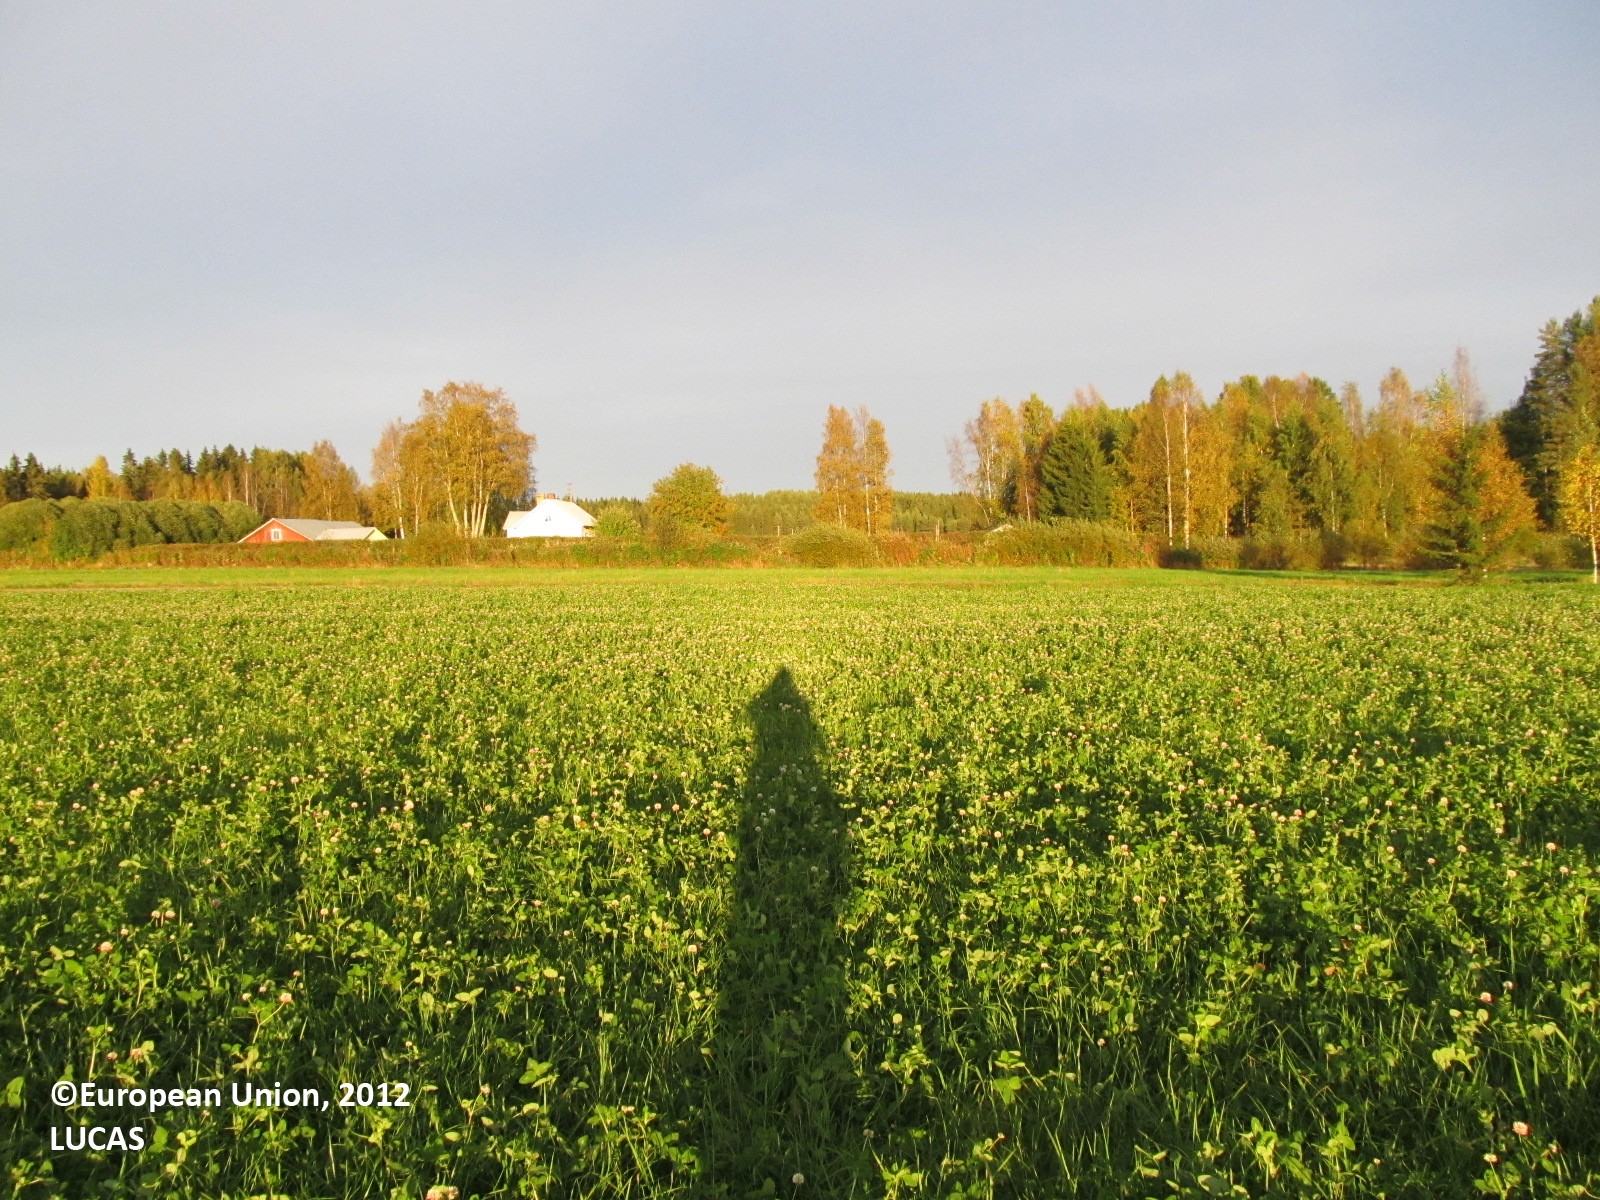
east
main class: Cropland
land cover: Clovers
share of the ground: > 75 %
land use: Agriculture (excluding fallow land and kitchen gardens)
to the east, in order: Clovers; Ditches and canals; Paved roads, cycling and walking lanes; Temporary grasslands; Lines of trees; Grassland without tree/shrub cover; Lines of trees; Common wheat
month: September
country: FI
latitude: 62.7021
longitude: 28.3102
